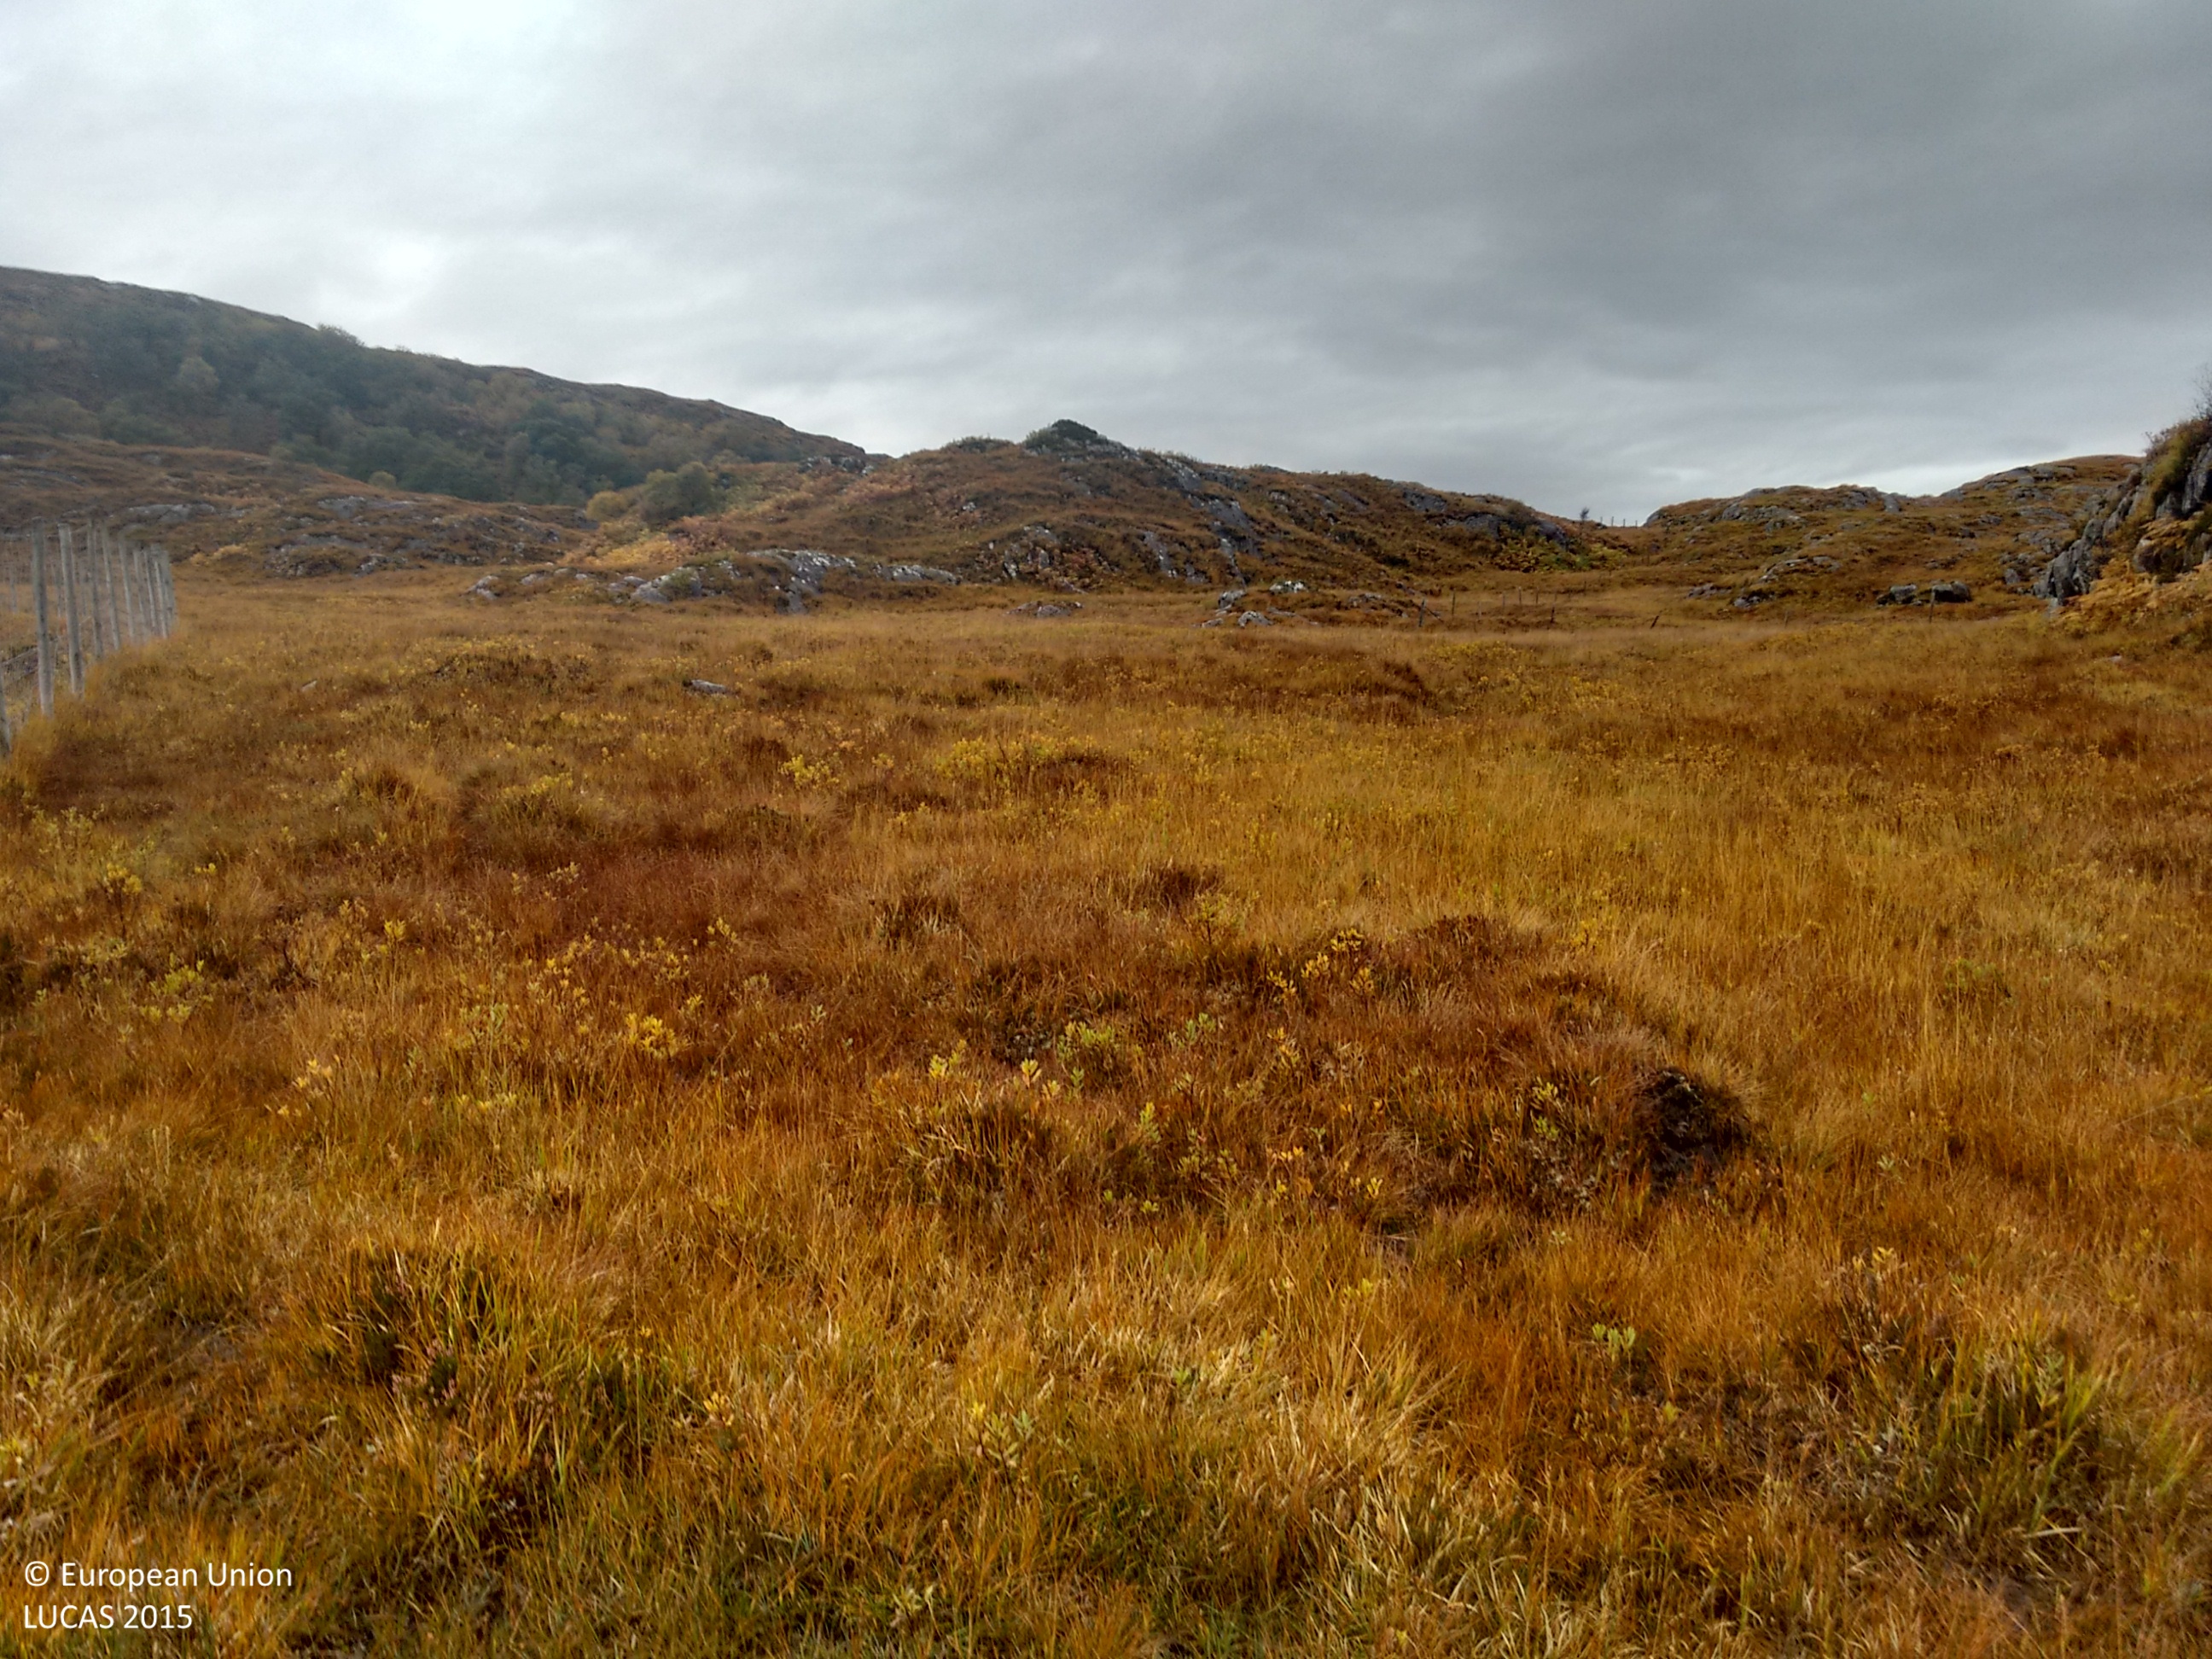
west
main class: Shrubland
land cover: Shrubland without tree cover
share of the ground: > 75 %
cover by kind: shrubs 80 %, herbaceous plants 20 %
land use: Agriculture (excluding fallow land and kitchen gardens)
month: October
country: GB
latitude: 56.7380
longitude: -5.8383
